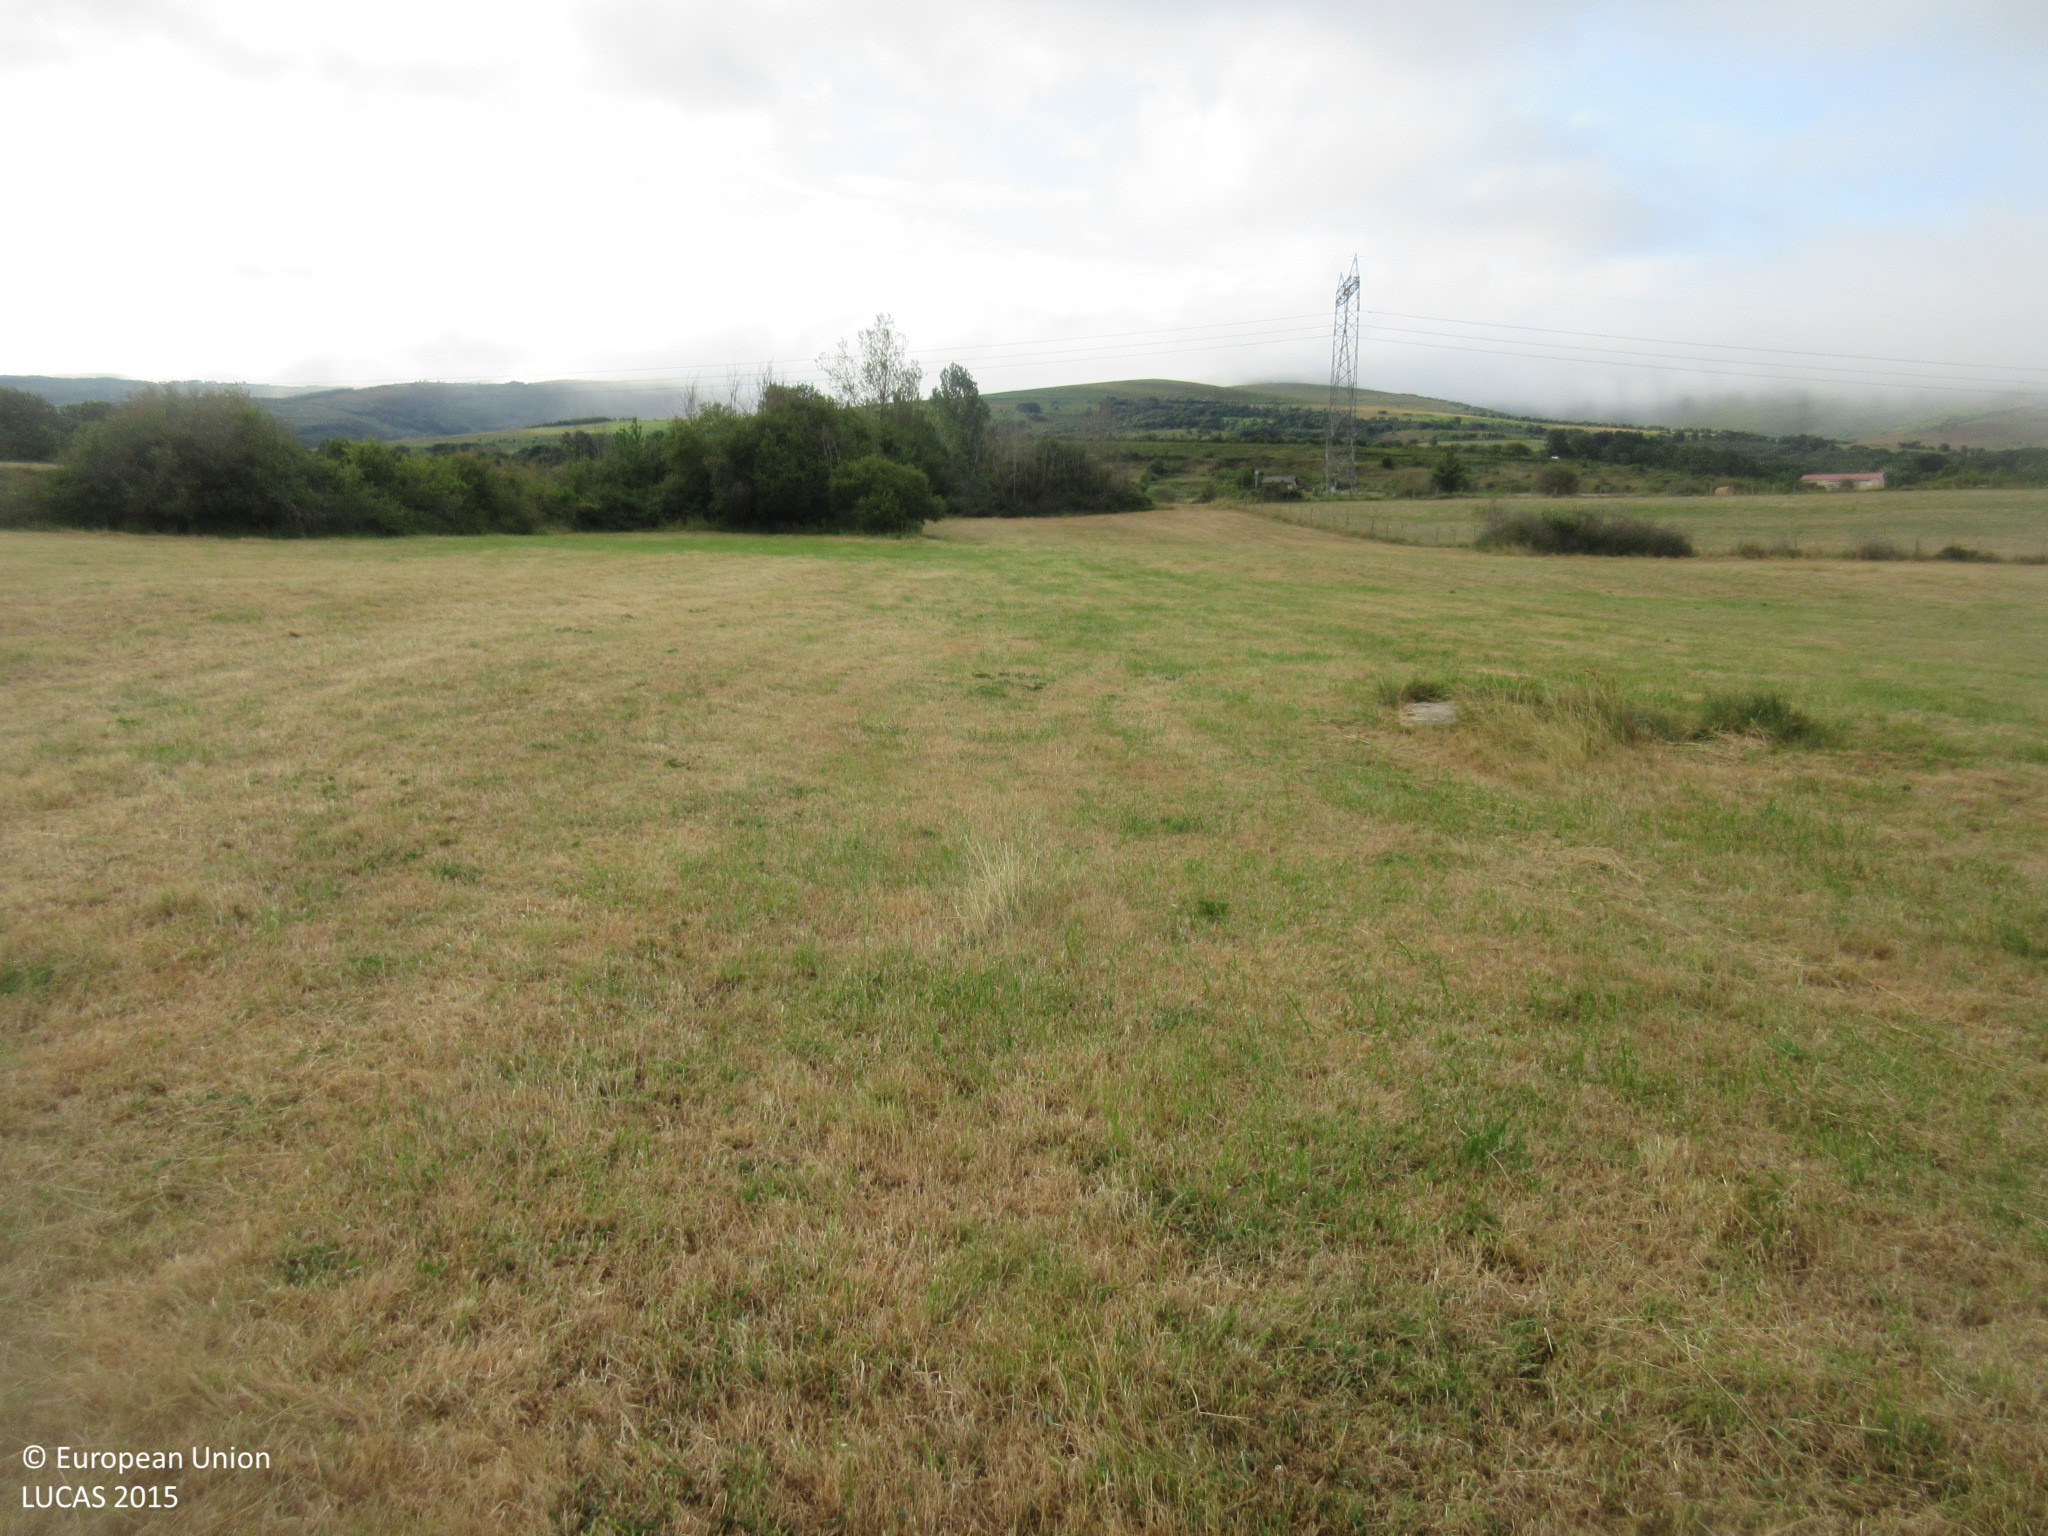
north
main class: Grassland
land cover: Grassland without tree/shrub cover
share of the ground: > 75 %
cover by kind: herbaceous plants 100 %
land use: Agriculture (excluding fallow land and kitchen gardens)
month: July
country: ES
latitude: 43.0813
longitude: -3.4903
